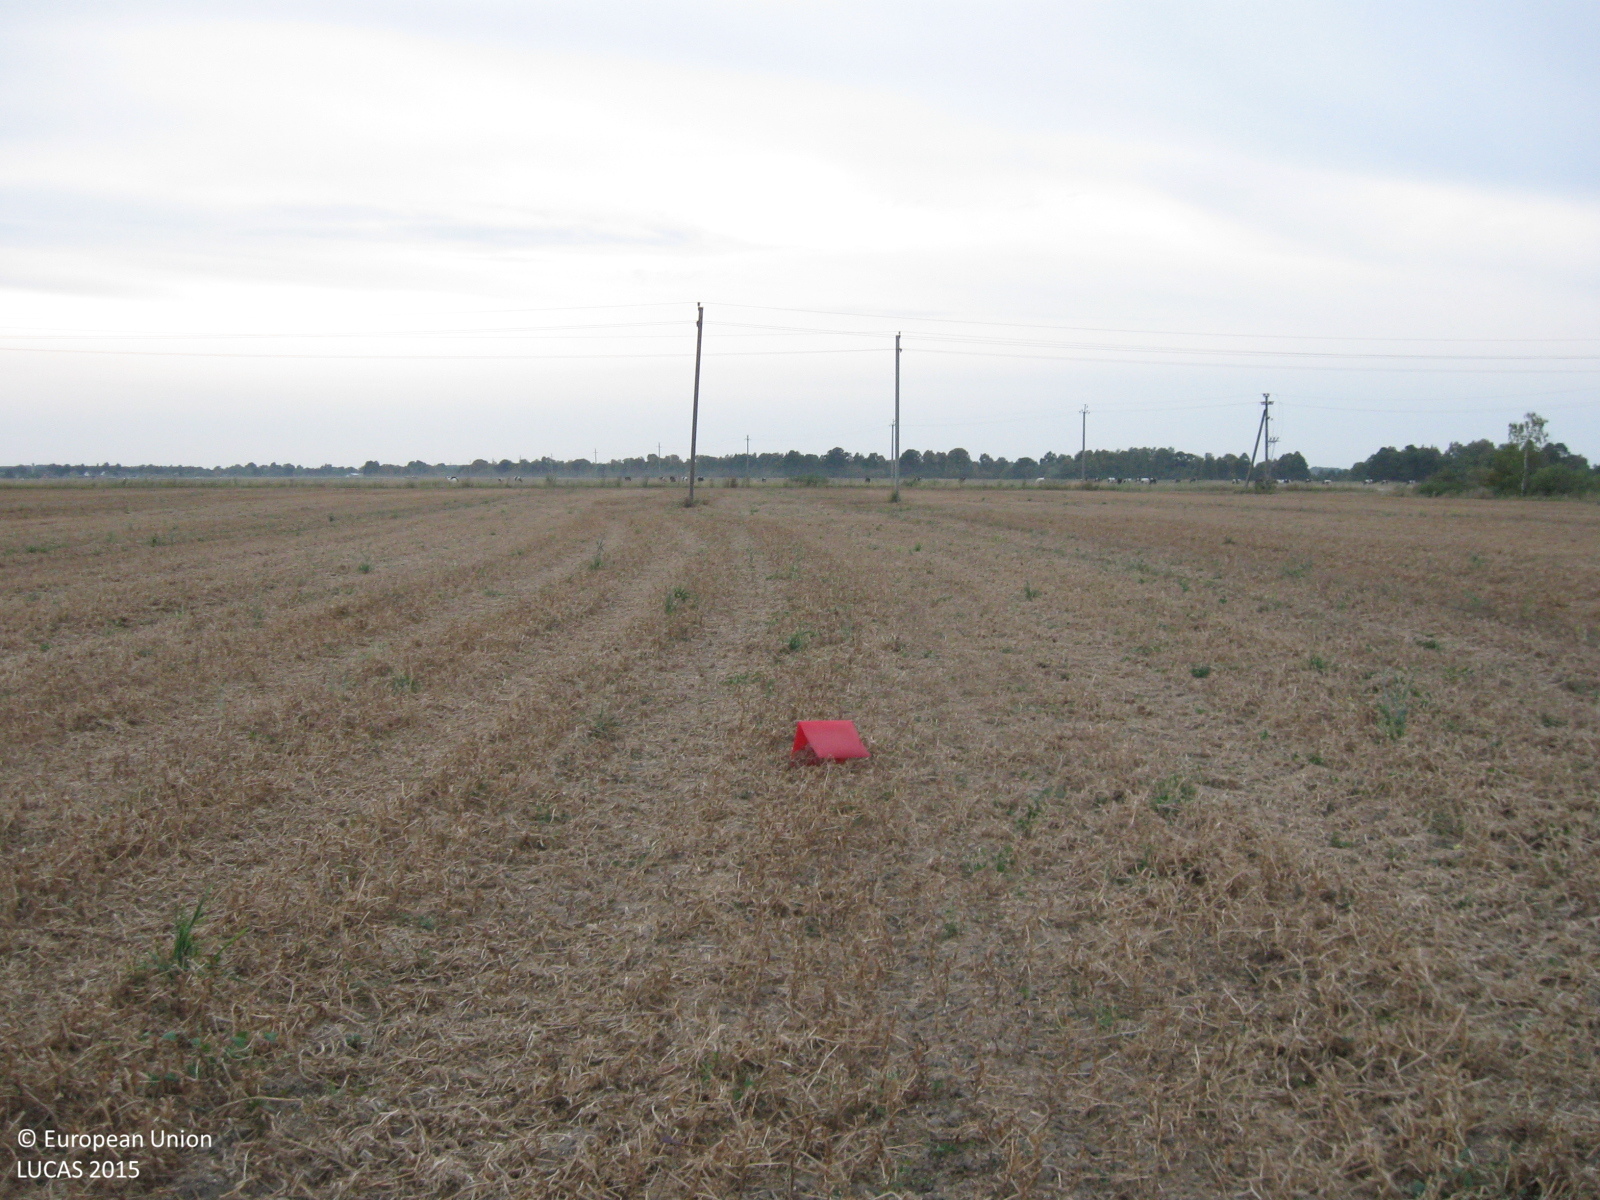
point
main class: Cropland
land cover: Dry pulses
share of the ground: 10 - 25 %
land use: Agriculture (excluding fallow land and kitchen gardens)
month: August
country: LT
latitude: 55.1816
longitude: 23.1230
